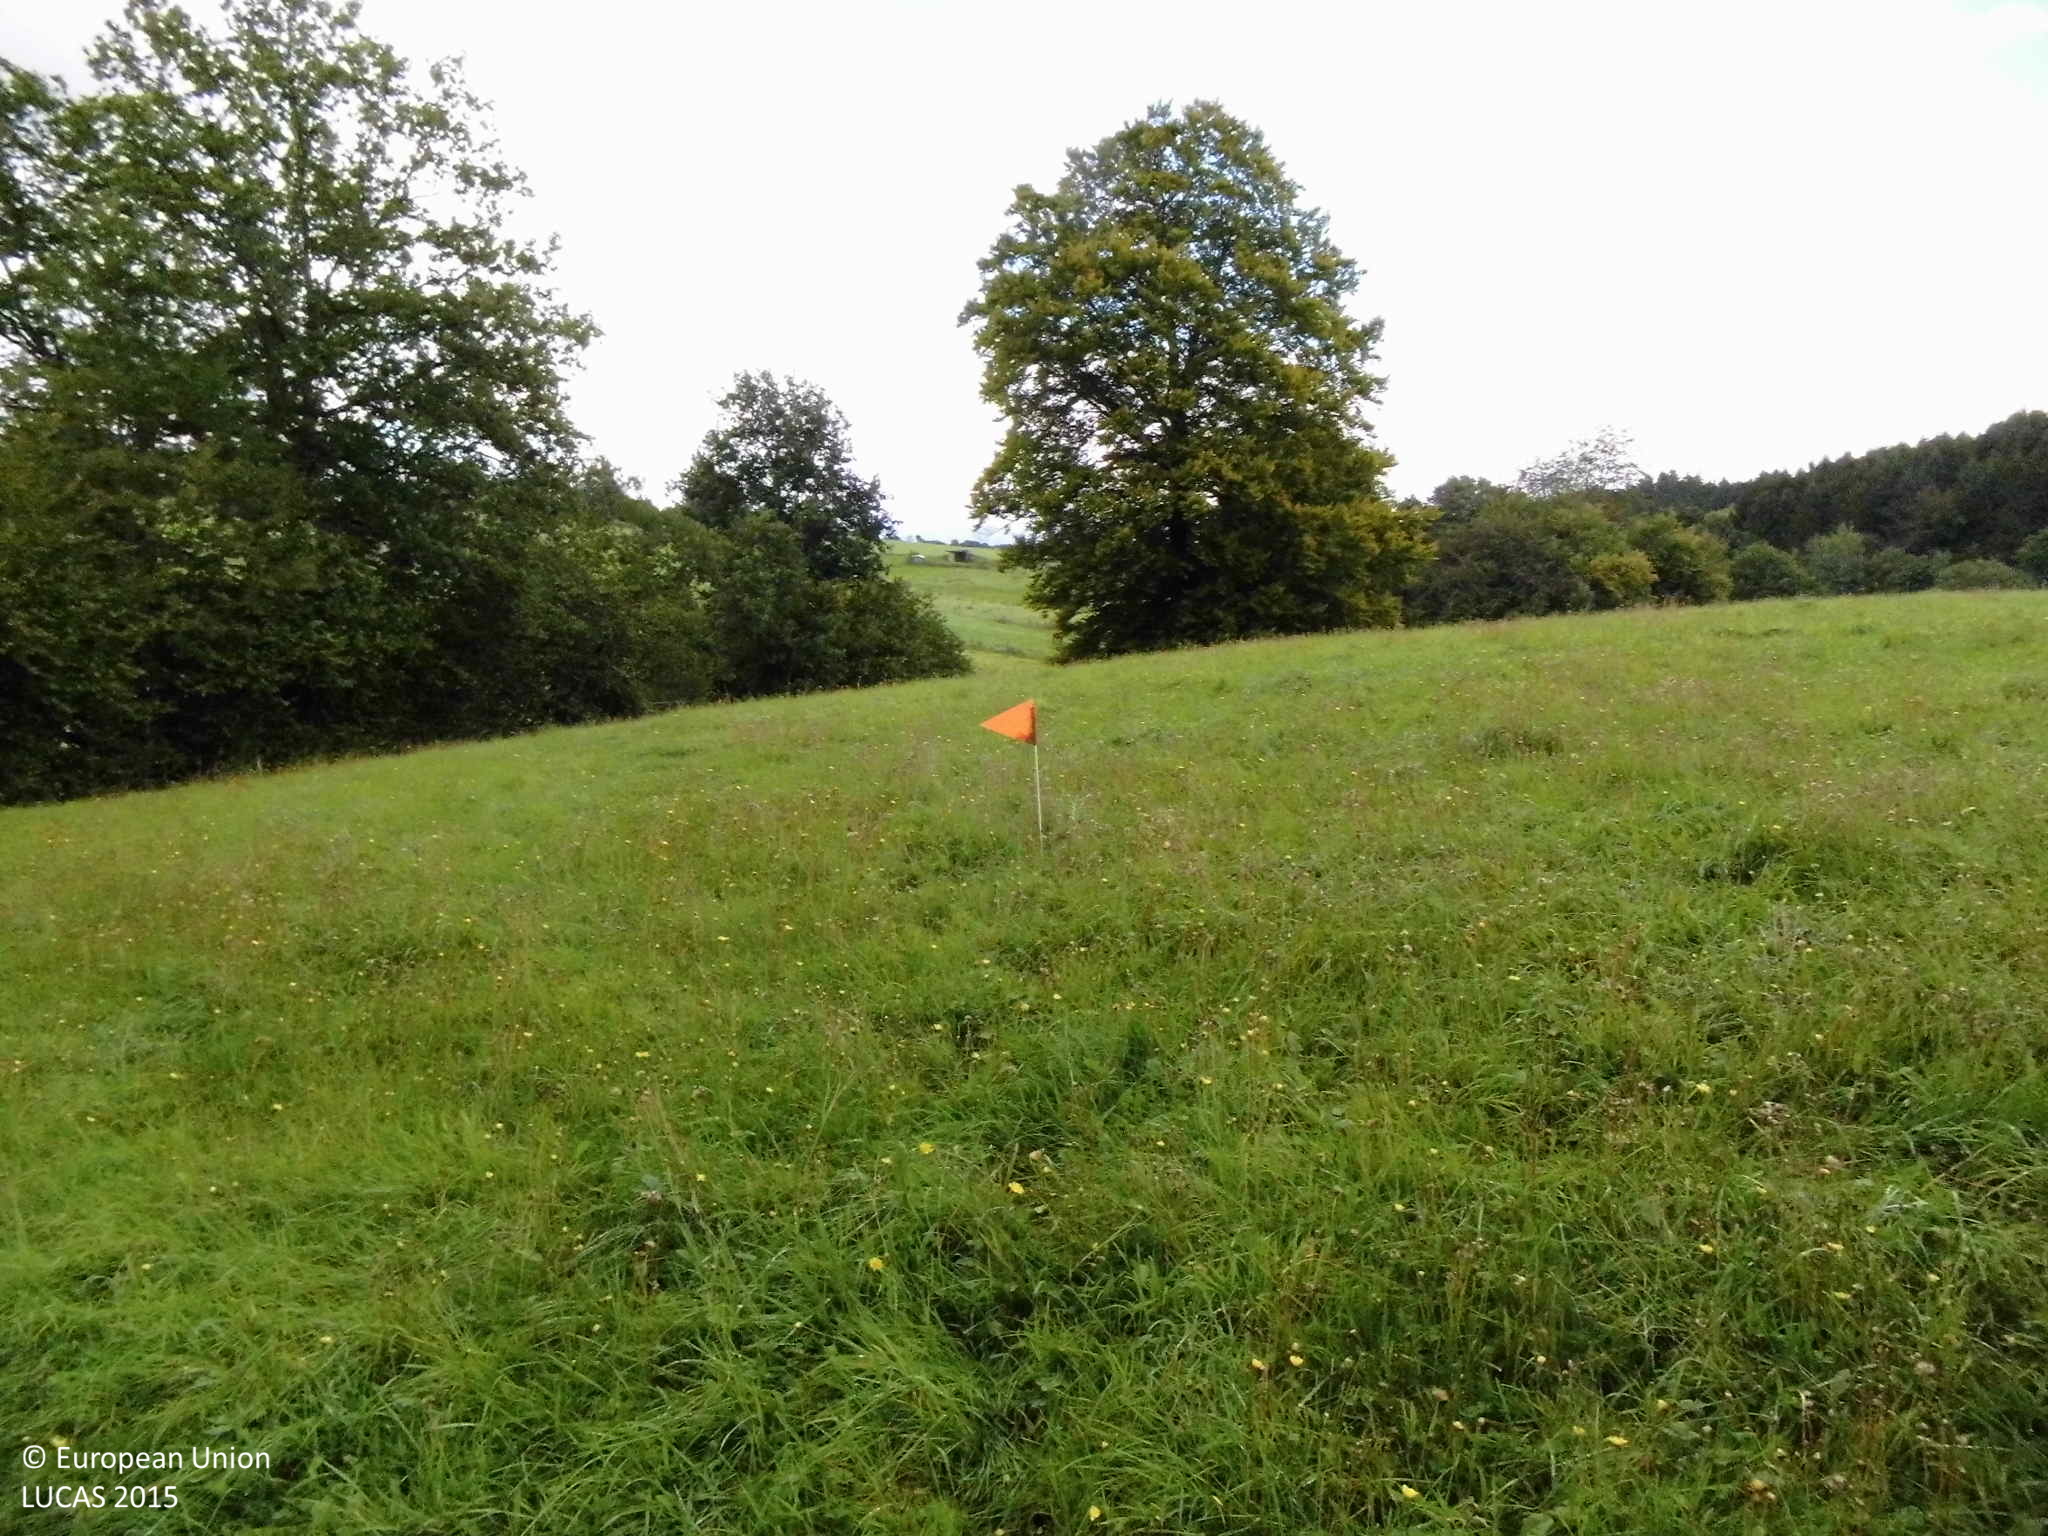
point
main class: Grassland
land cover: Grassland without tree/shrub cover
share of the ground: > 75 %
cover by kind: herbaceous plants 100 %
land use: Agriculture (excluding fallow land and kitchen gardens)
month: September
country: DE
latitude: 50.6592
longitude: 7.4398
